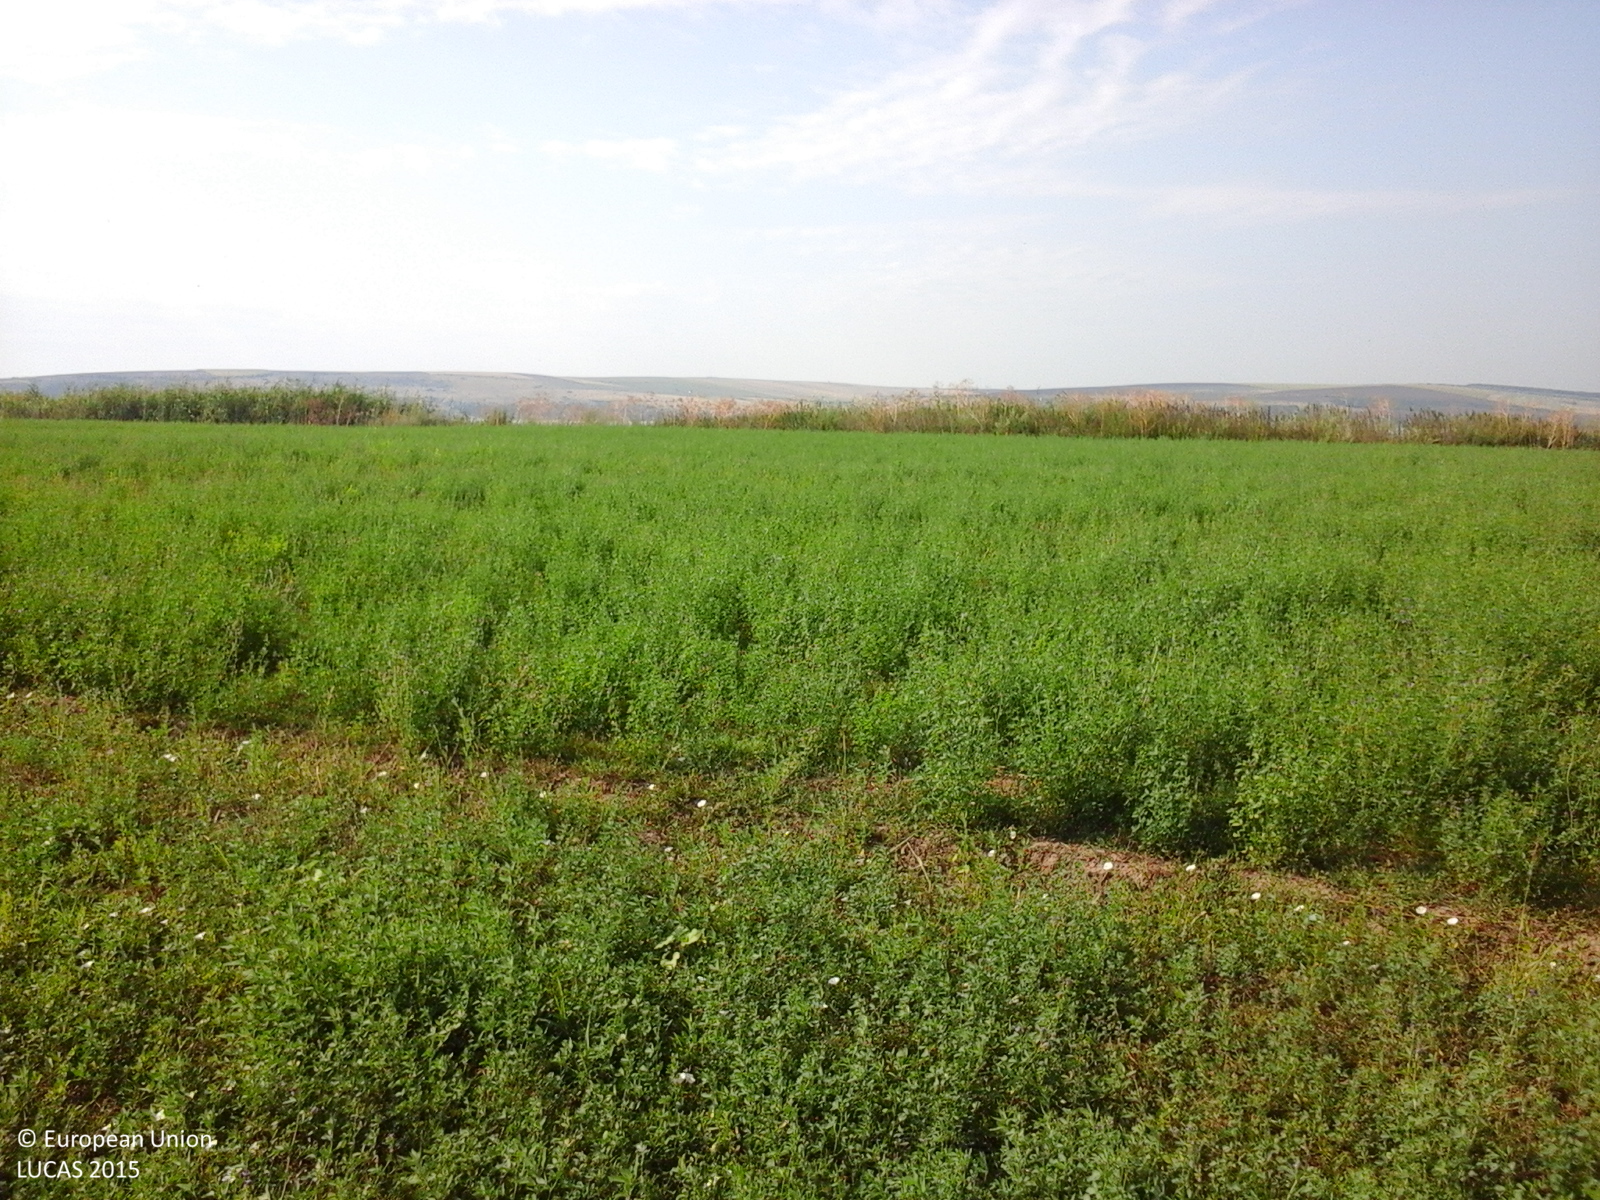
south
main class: Cropland
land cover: Lucerne
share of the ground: > 75 %
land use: Agriculture (excluding fallow land and kitchen gardens)
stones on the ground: < 10 %
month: August
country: RO
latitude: 44.0945
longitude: 27.4361
